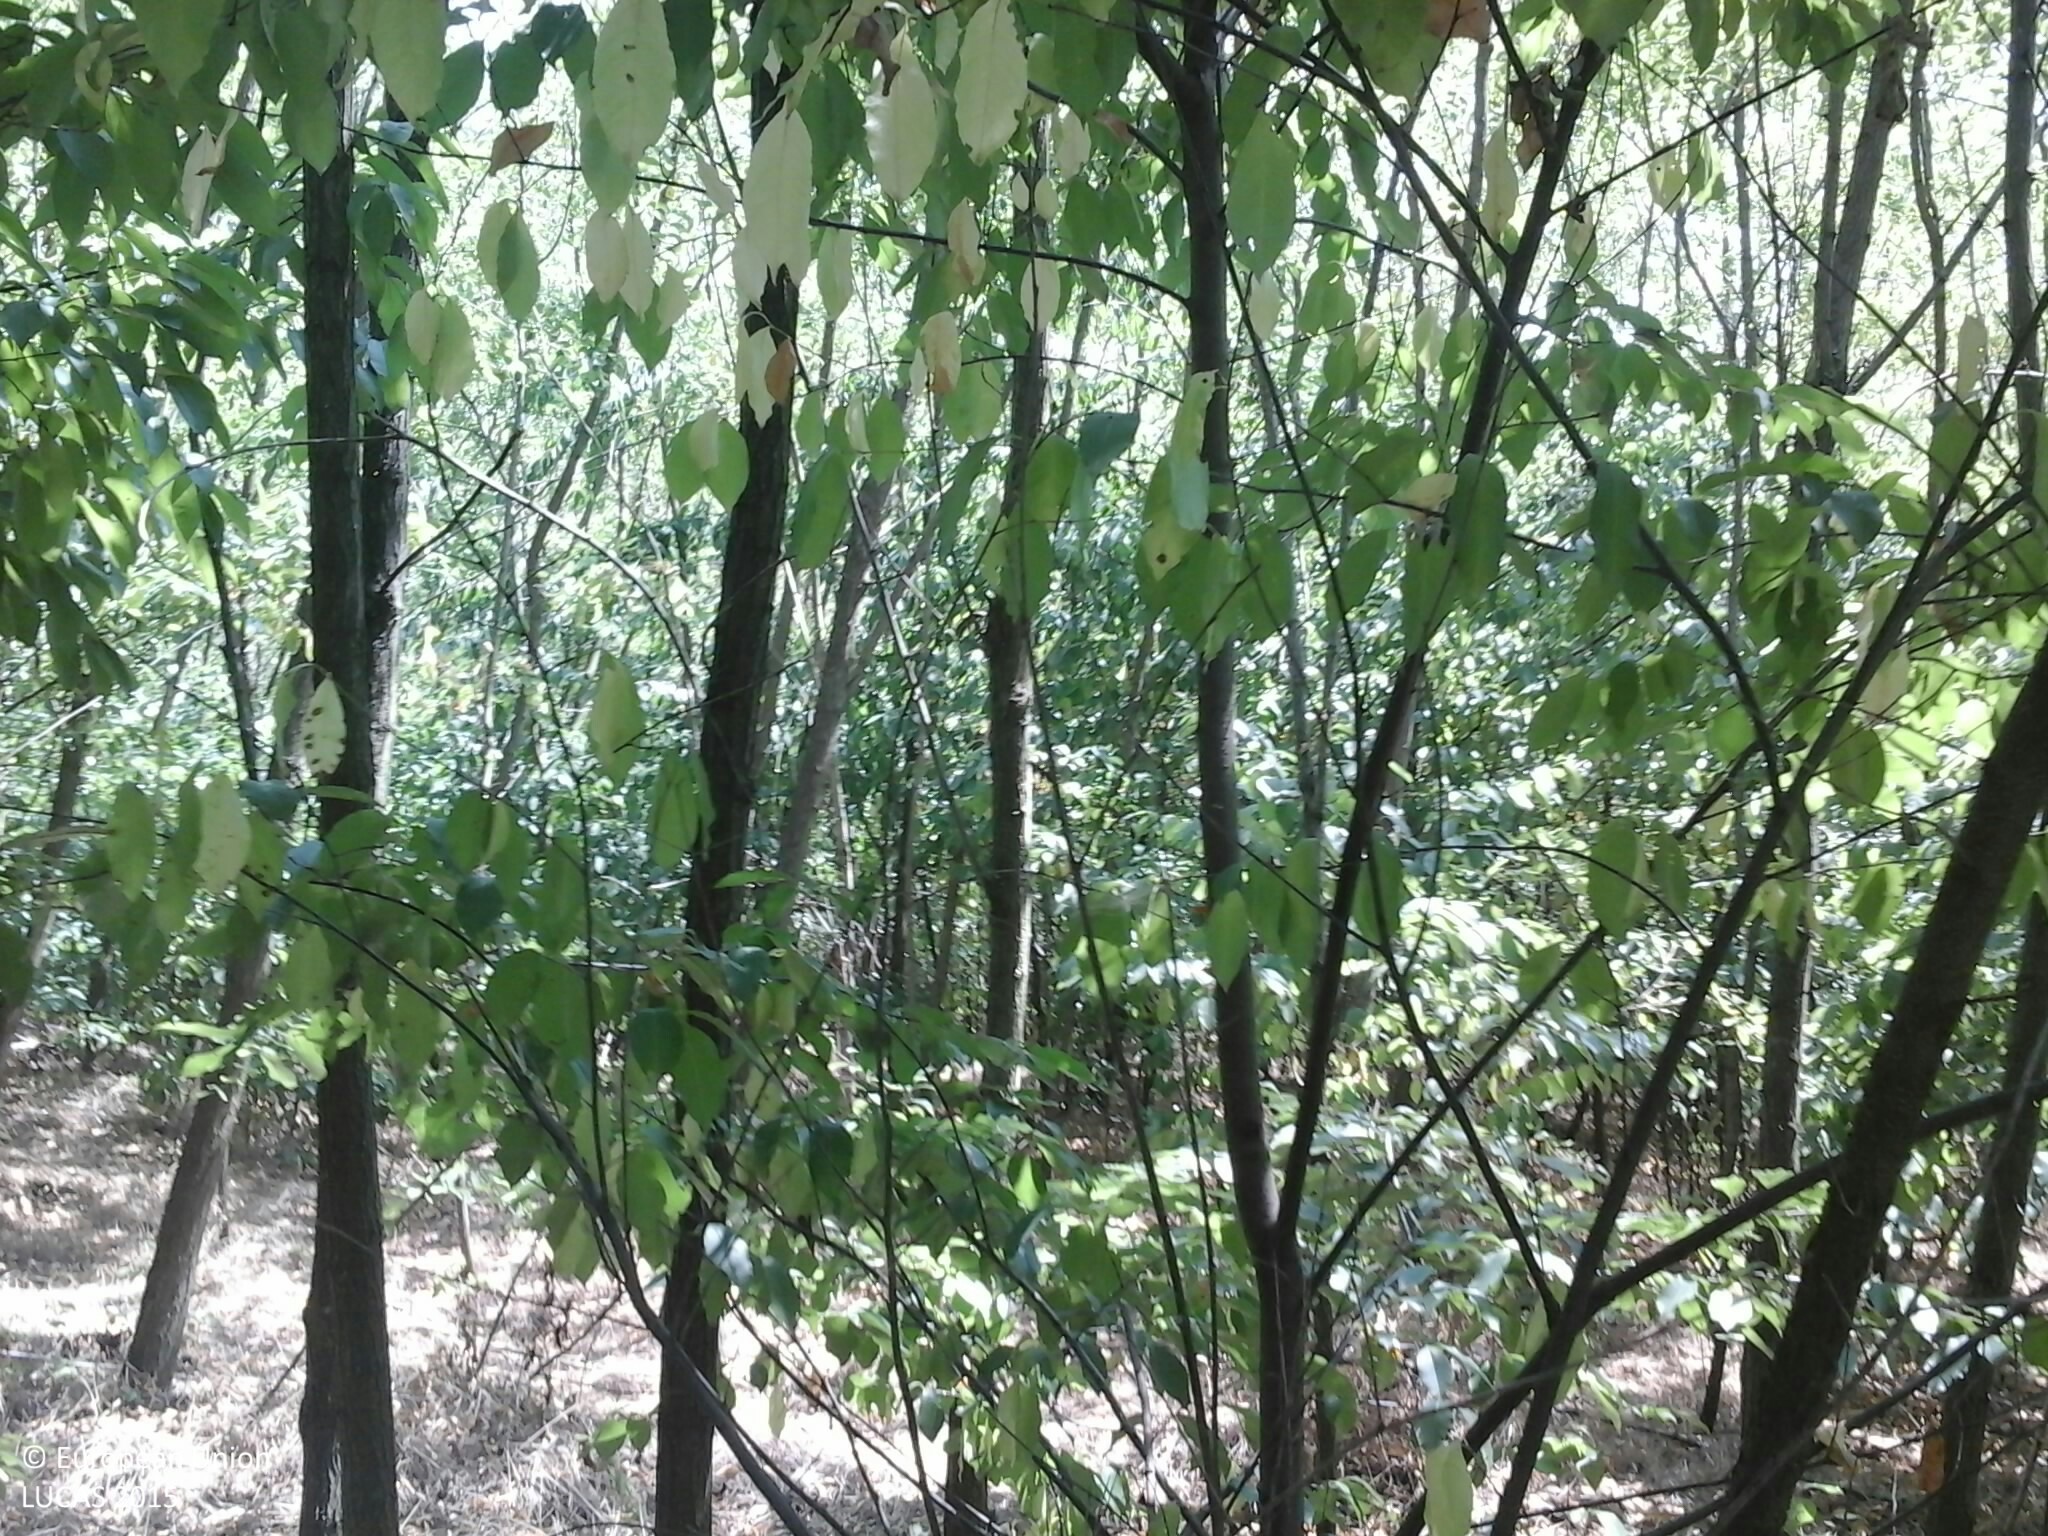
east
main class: Woodland
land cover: Broadleaved woodland
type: mesophytic deciduous forest
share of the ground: > 75 %
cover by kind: broadleaved forest trees 95 %, herbaceous plants 5 %
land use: Forestry
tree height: > 5 m
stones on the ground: < 10 %
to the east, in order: Broadleaved woodland; Tracks; Broadleaved woodland; Shrubland with sparse tree cover
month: July
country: HU
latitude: 47.7663
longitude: 22.3175
